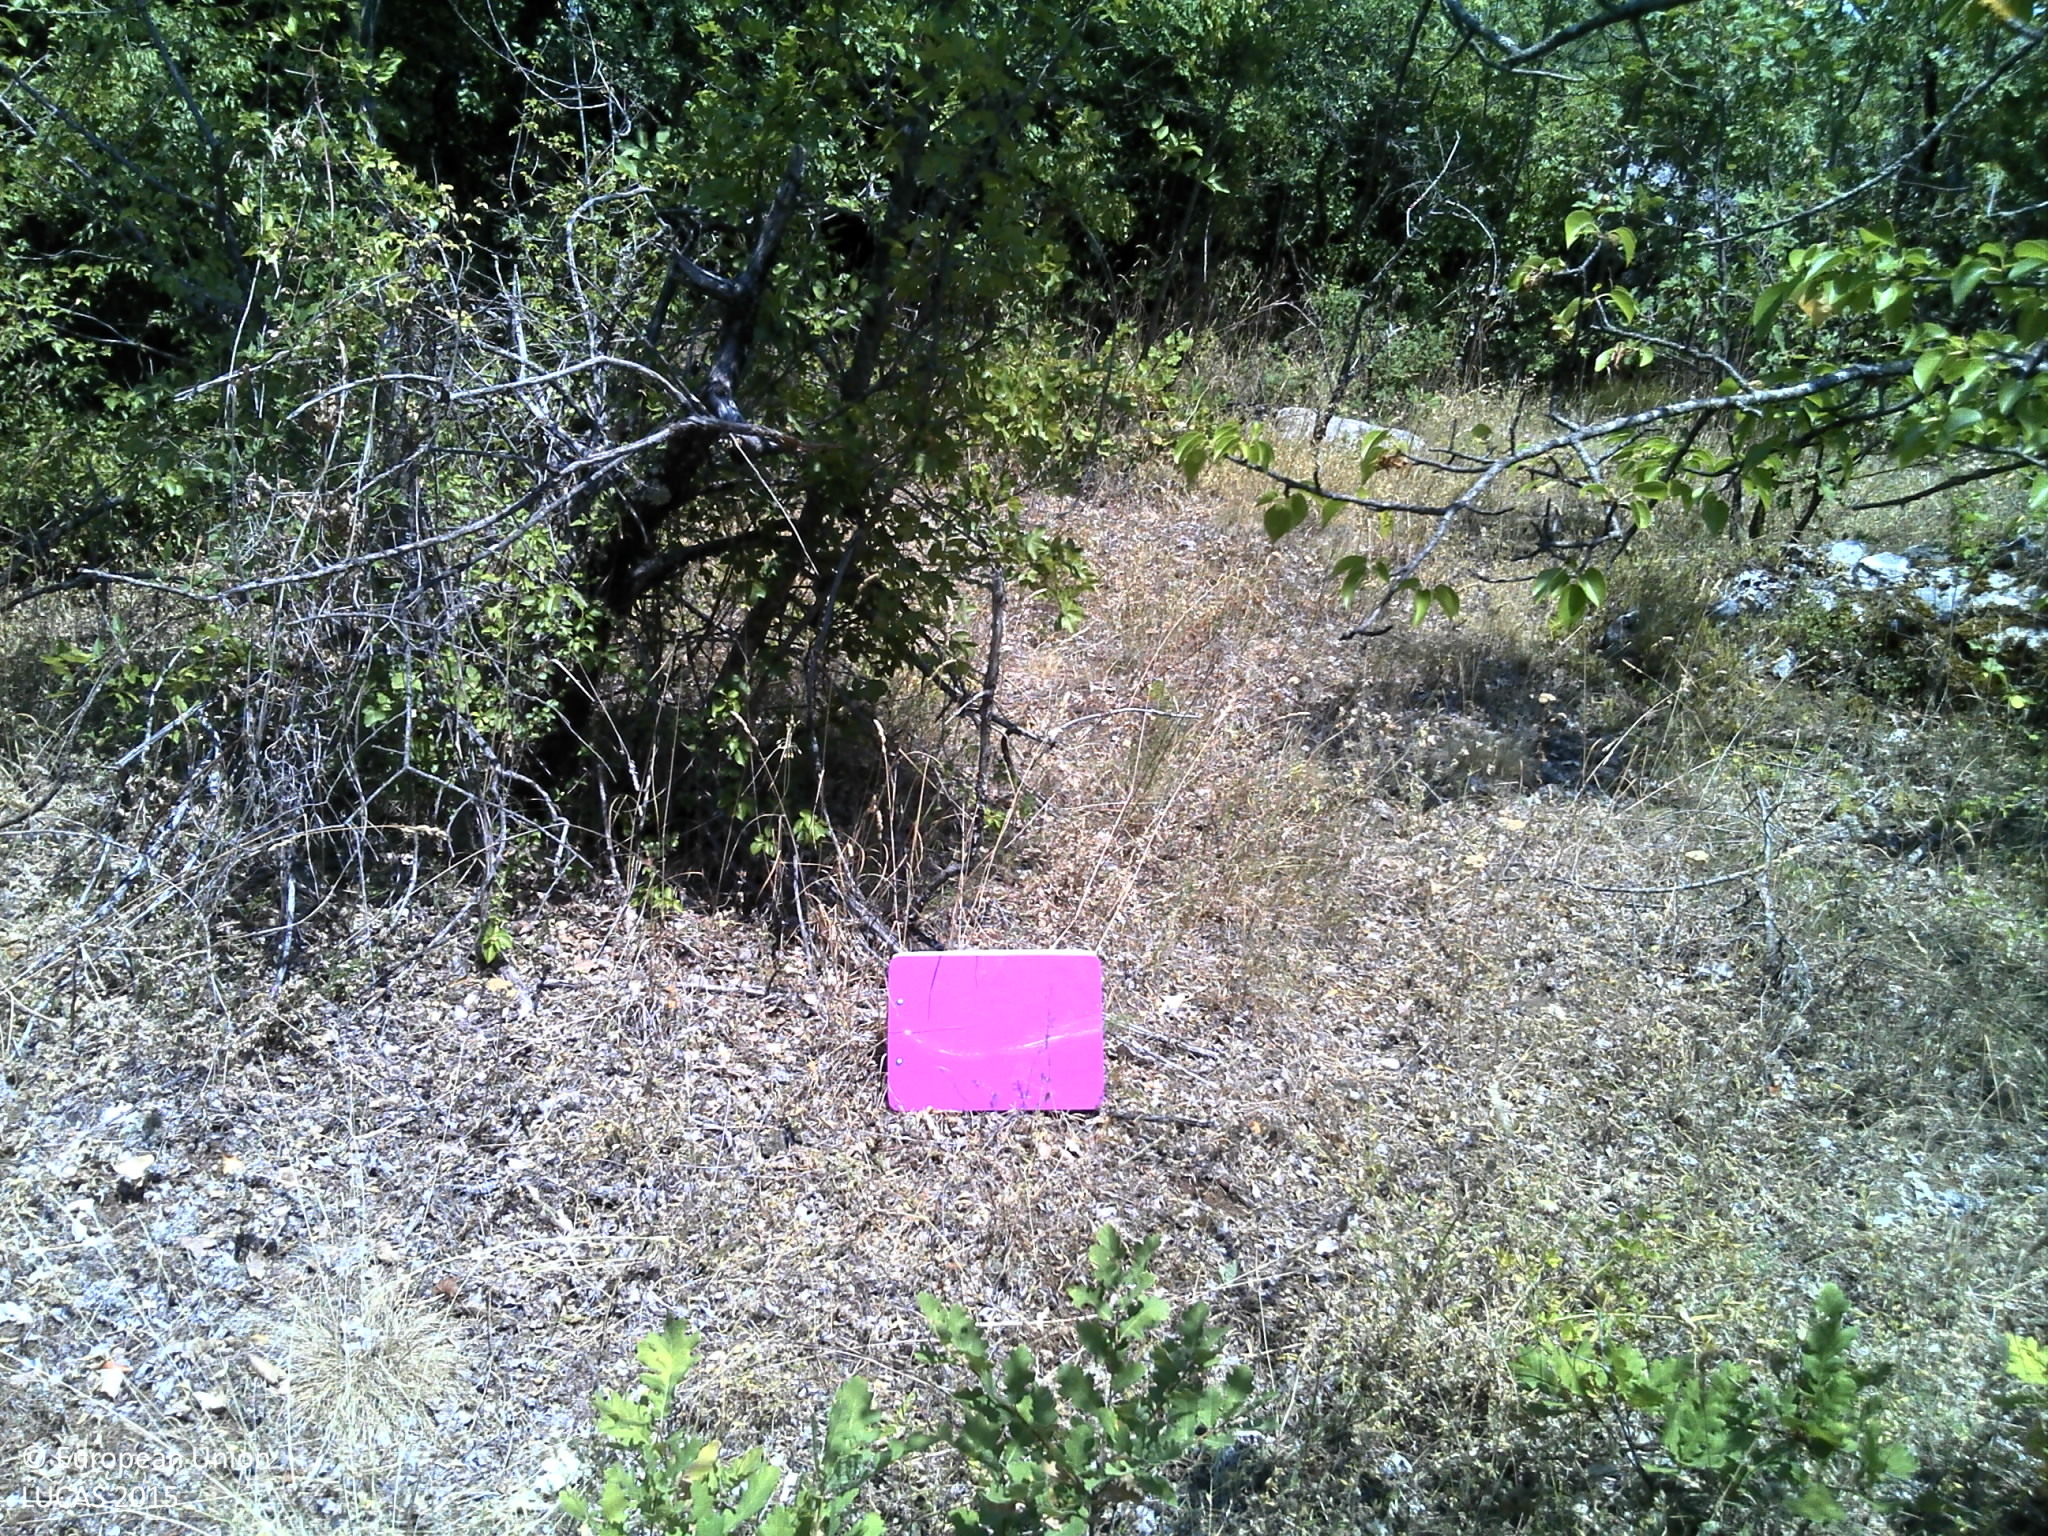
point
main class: Shrubland
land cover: Shrubland with sparse tree cover
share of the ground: > 75 %
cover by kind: shrubs 60 %, herbaceous plants 15 %, unconsolidated bare surface 15 %, broadleaved forest trees 5 %, consolidated bare surface 5 %
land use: Semi-natural and natural areas not in use
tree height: > 5 m
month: July
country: HR
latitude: 43.4820
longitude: 16.9771
